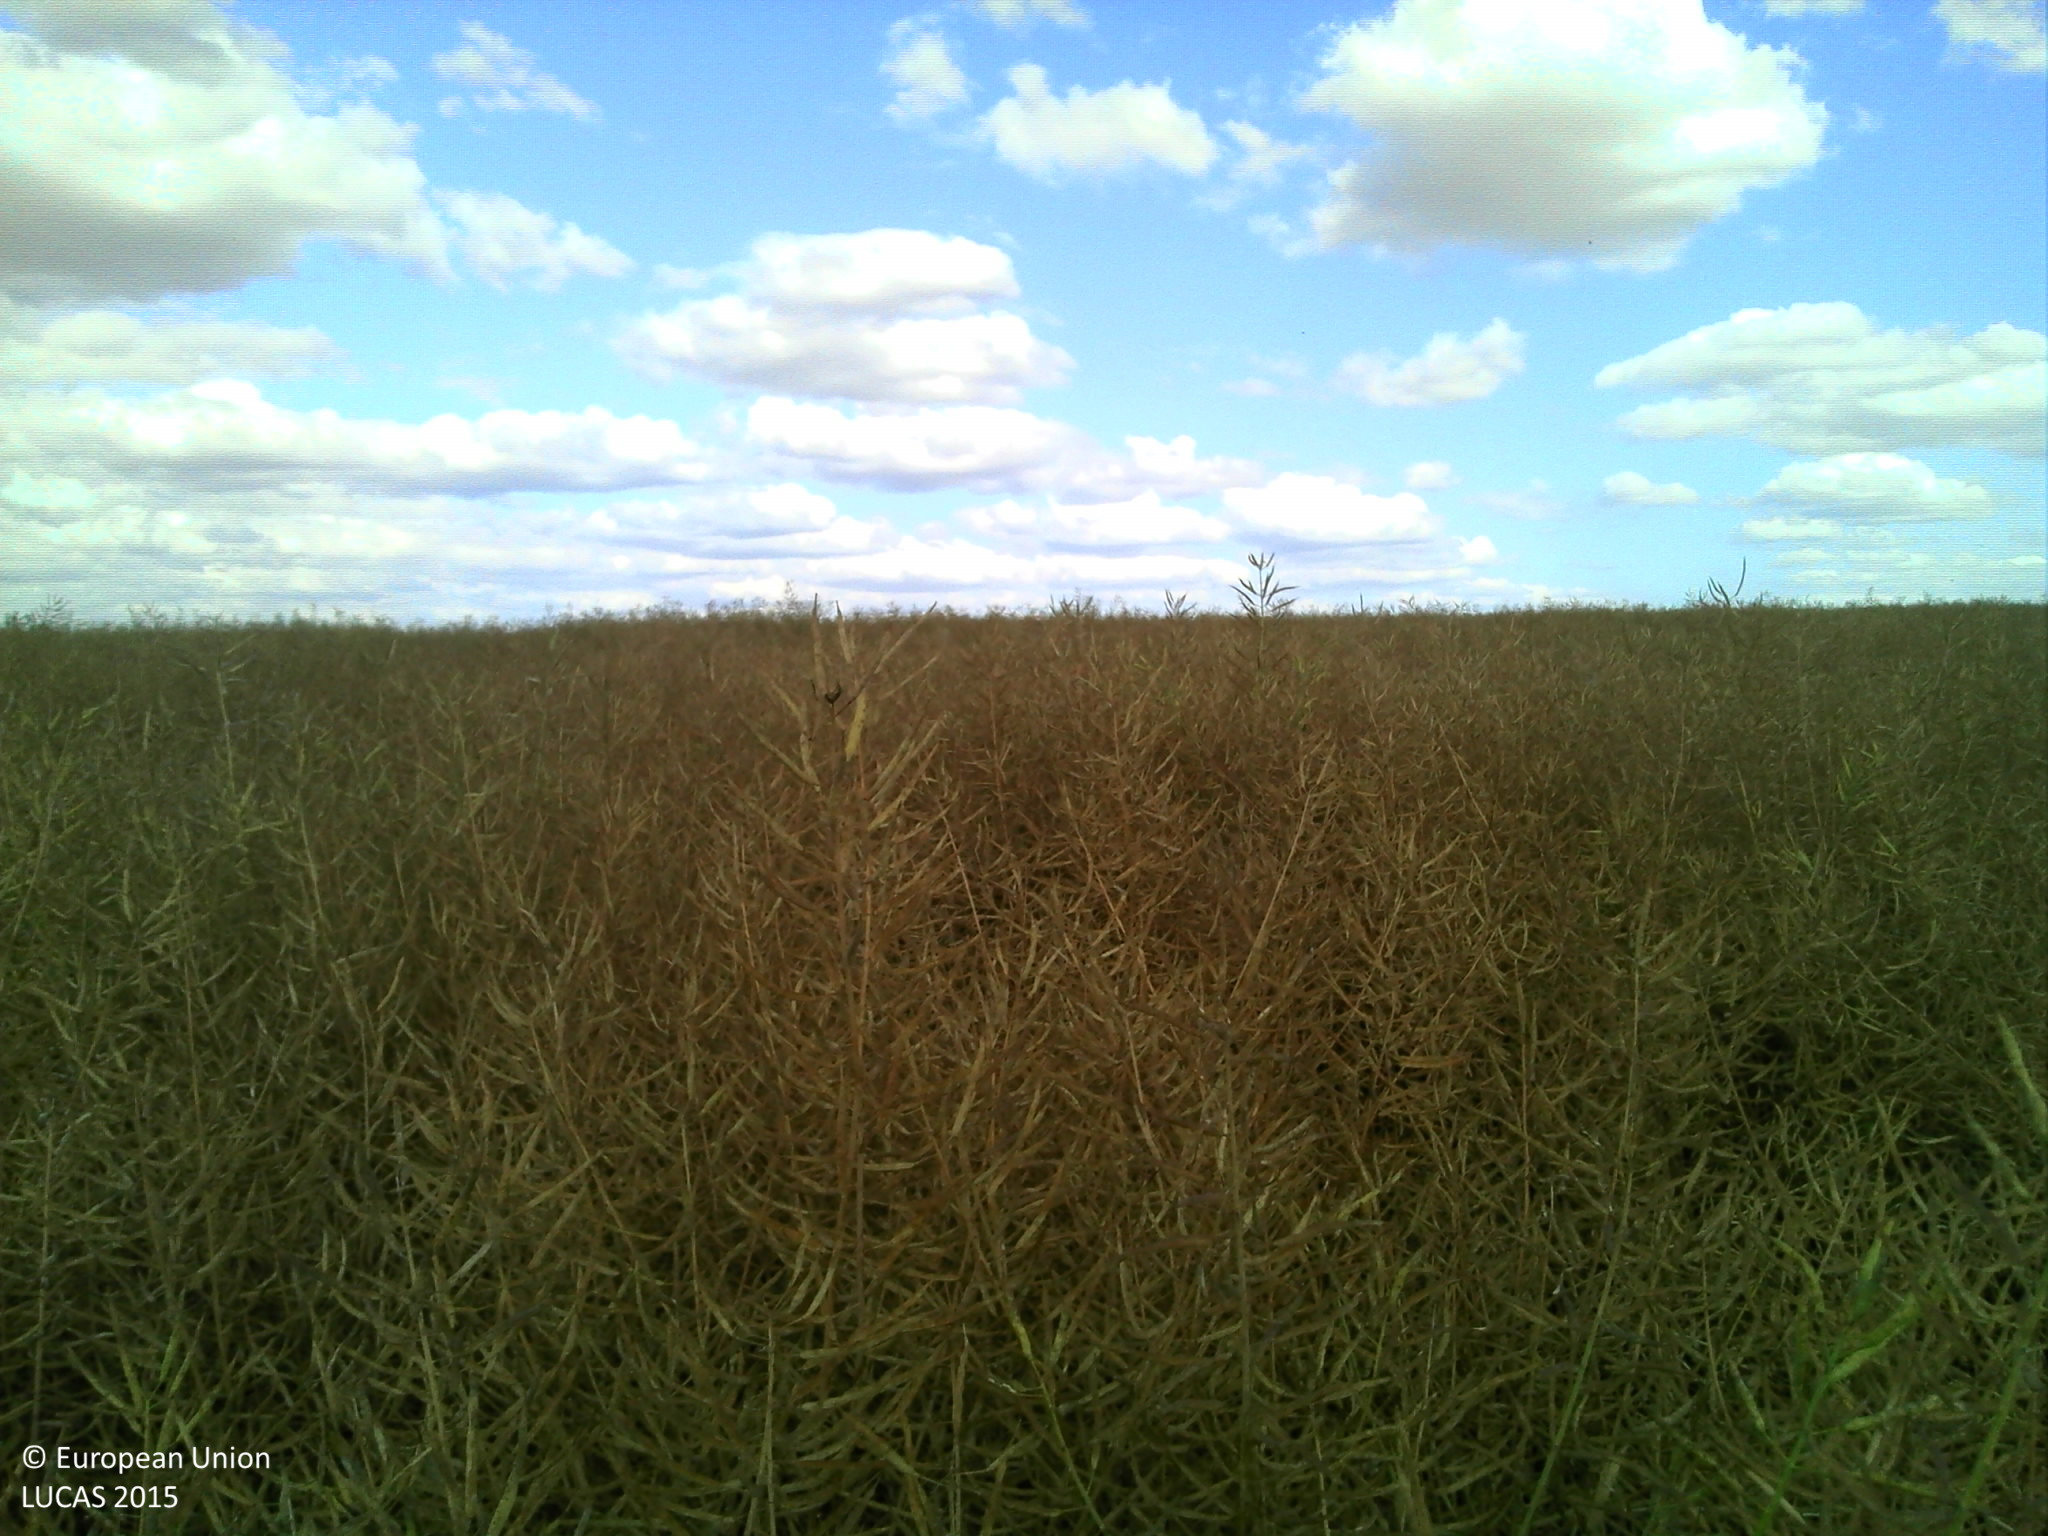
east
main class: Cropland
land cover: Rape and turnip rape
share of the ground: > 75 %
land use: Agriculture (excluding fallow land and kitchen gardens)
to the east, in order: Rape and turnip rape; Common wheat
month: July
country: FR
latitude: 48.9628
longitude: 5.1220
